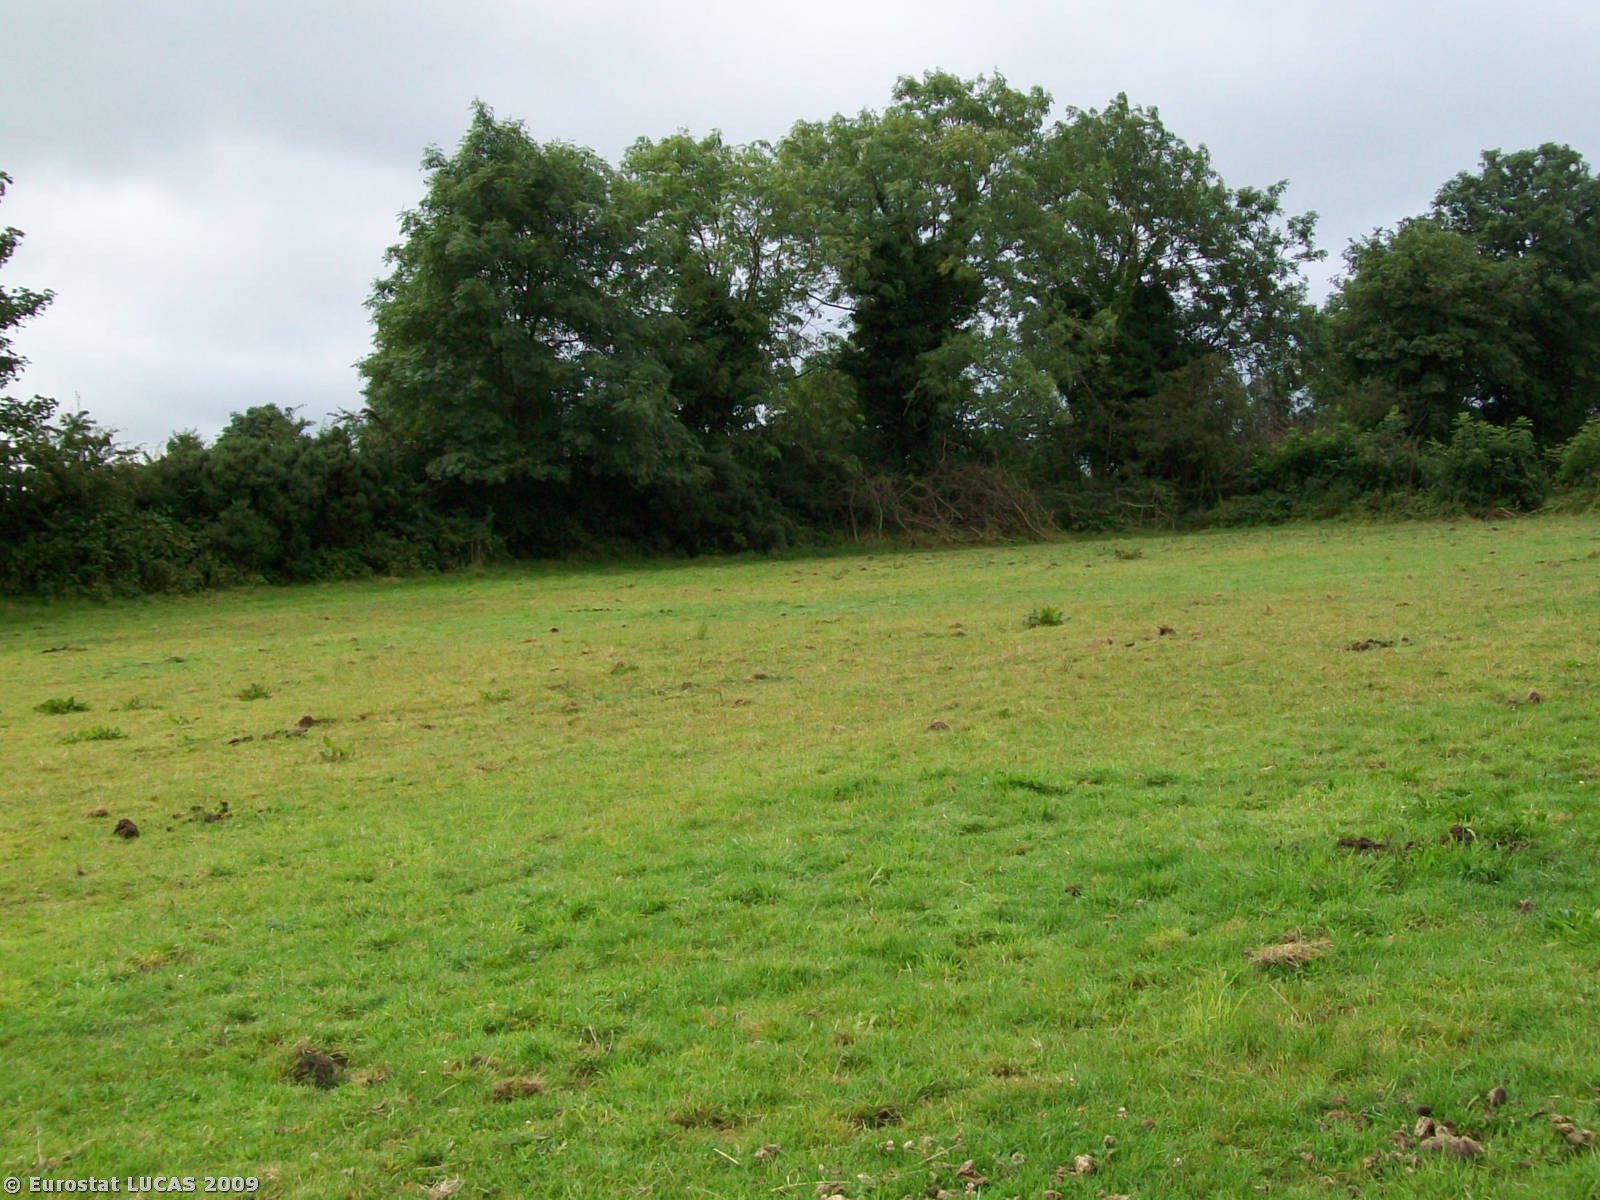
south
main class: Grassland
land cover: Grassland without tree/shrub cover
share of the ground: > 75 %
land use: Agriculture (excluding fallow land and kitchen gardens)
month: August
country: GB
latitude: 54.0923
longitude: -6.5320
